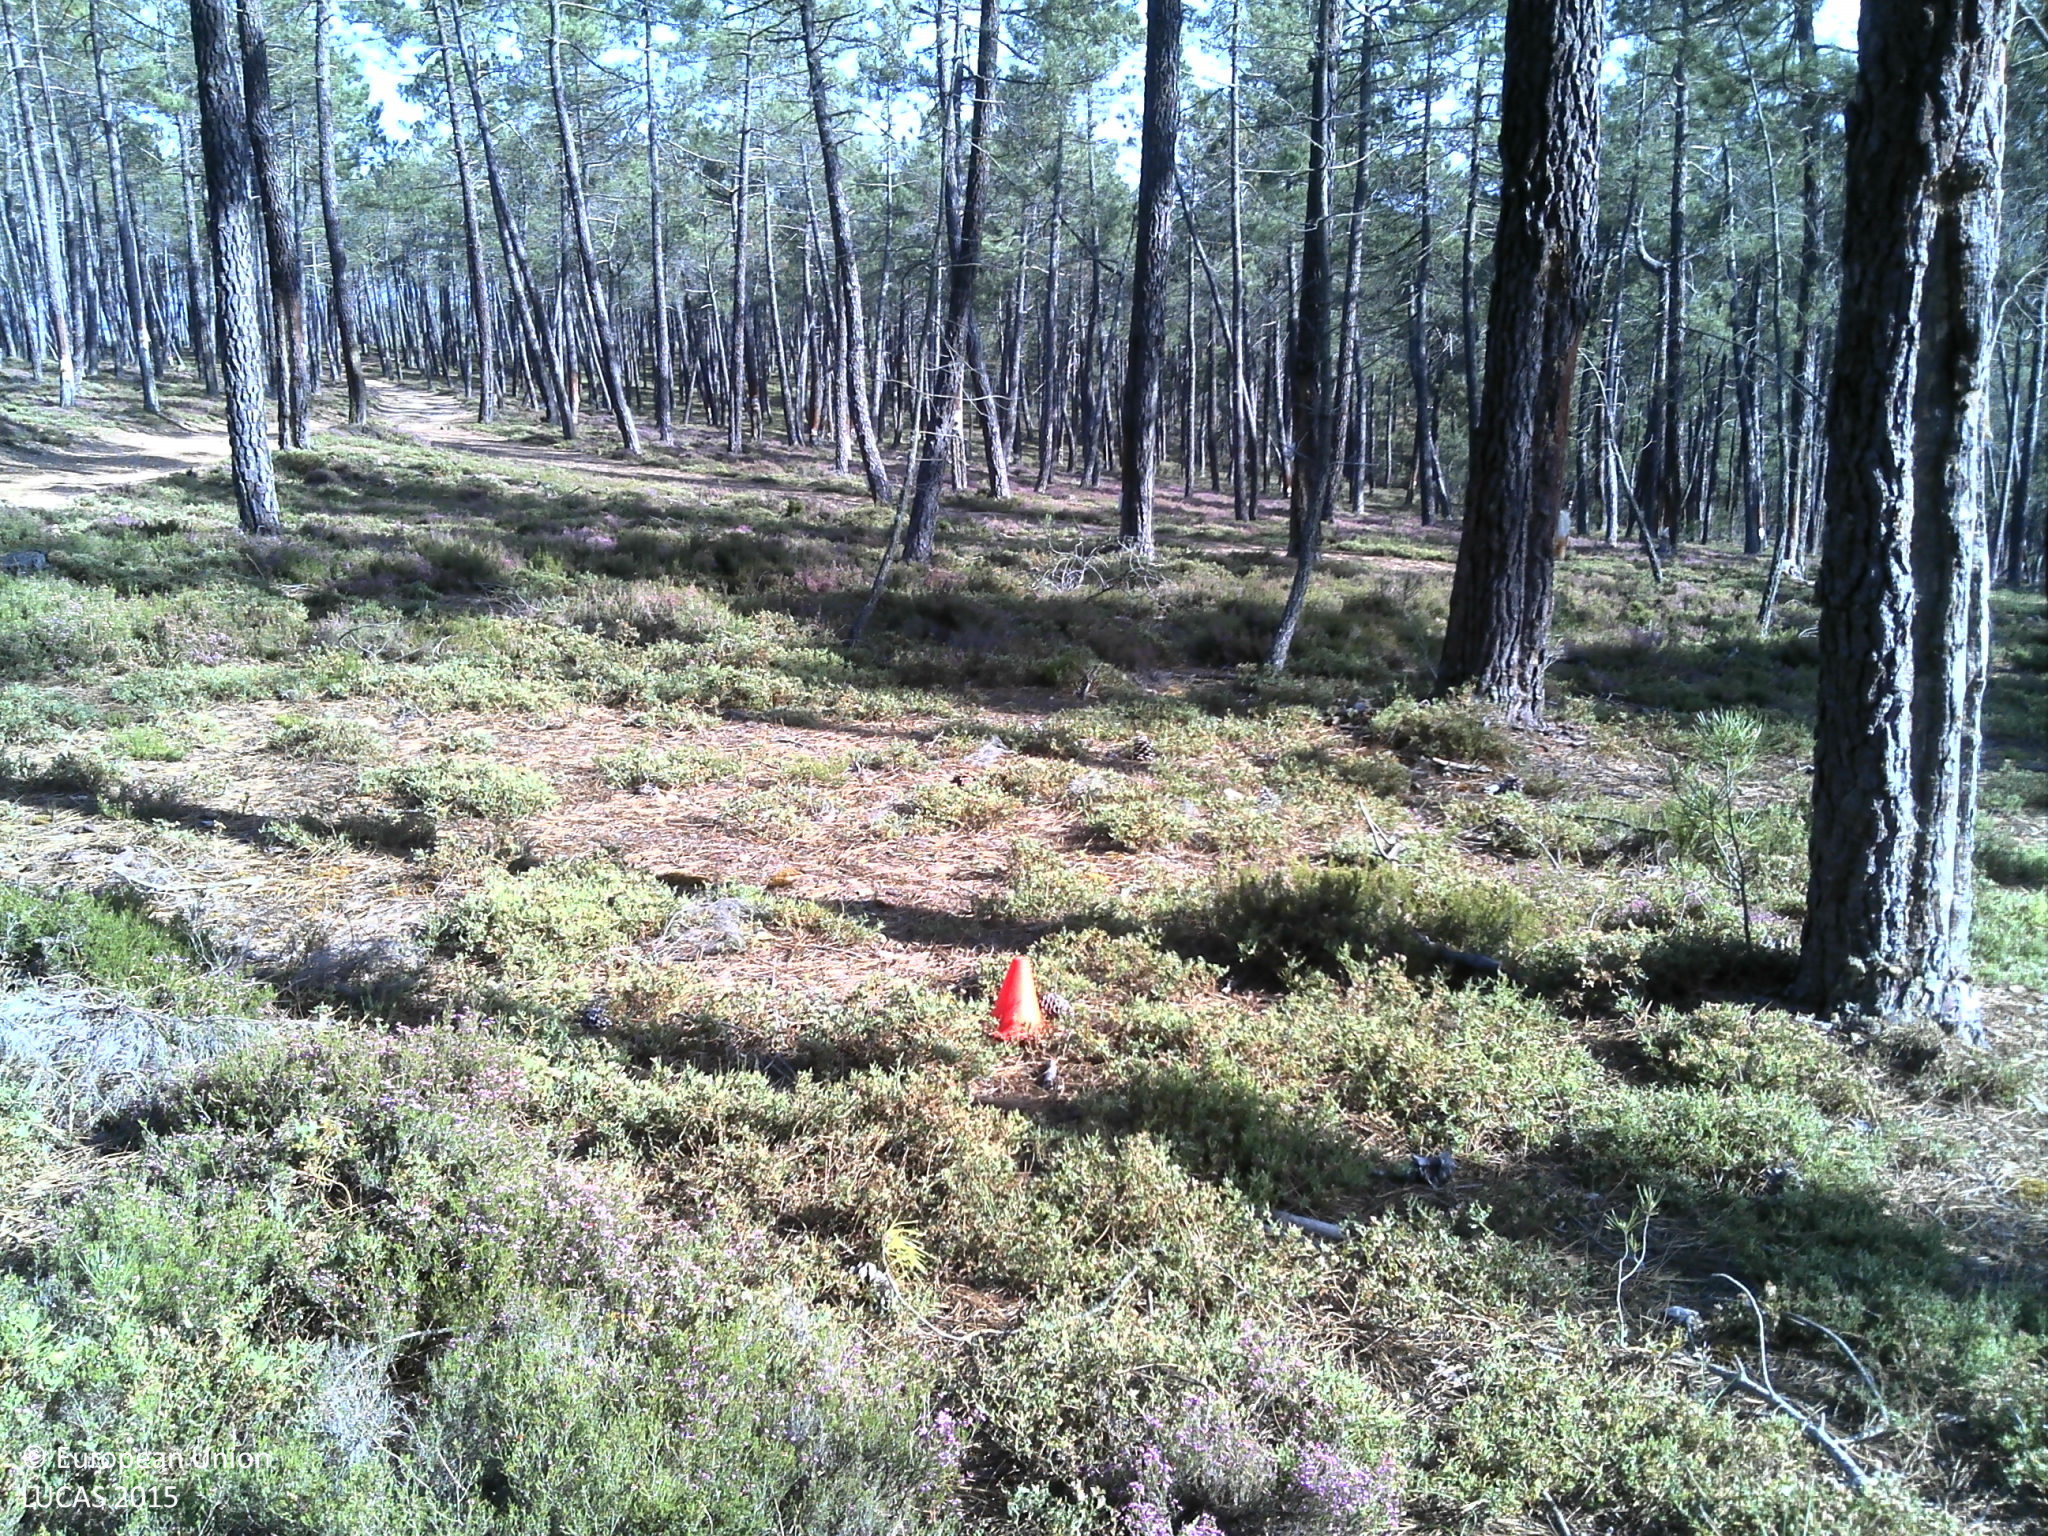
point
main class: Woodland
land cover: Pine dominated coniferous woodland
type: coniferous forest of the mediterranean region
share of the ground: 25 - 50 %
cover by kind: coniferous forest trees 40 %, shrubs 40 %, unconsolidated bare surface 20 %
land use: Forestry
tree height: > 5 m
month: May
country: PT
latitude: 41.4843
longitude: -7.5051
